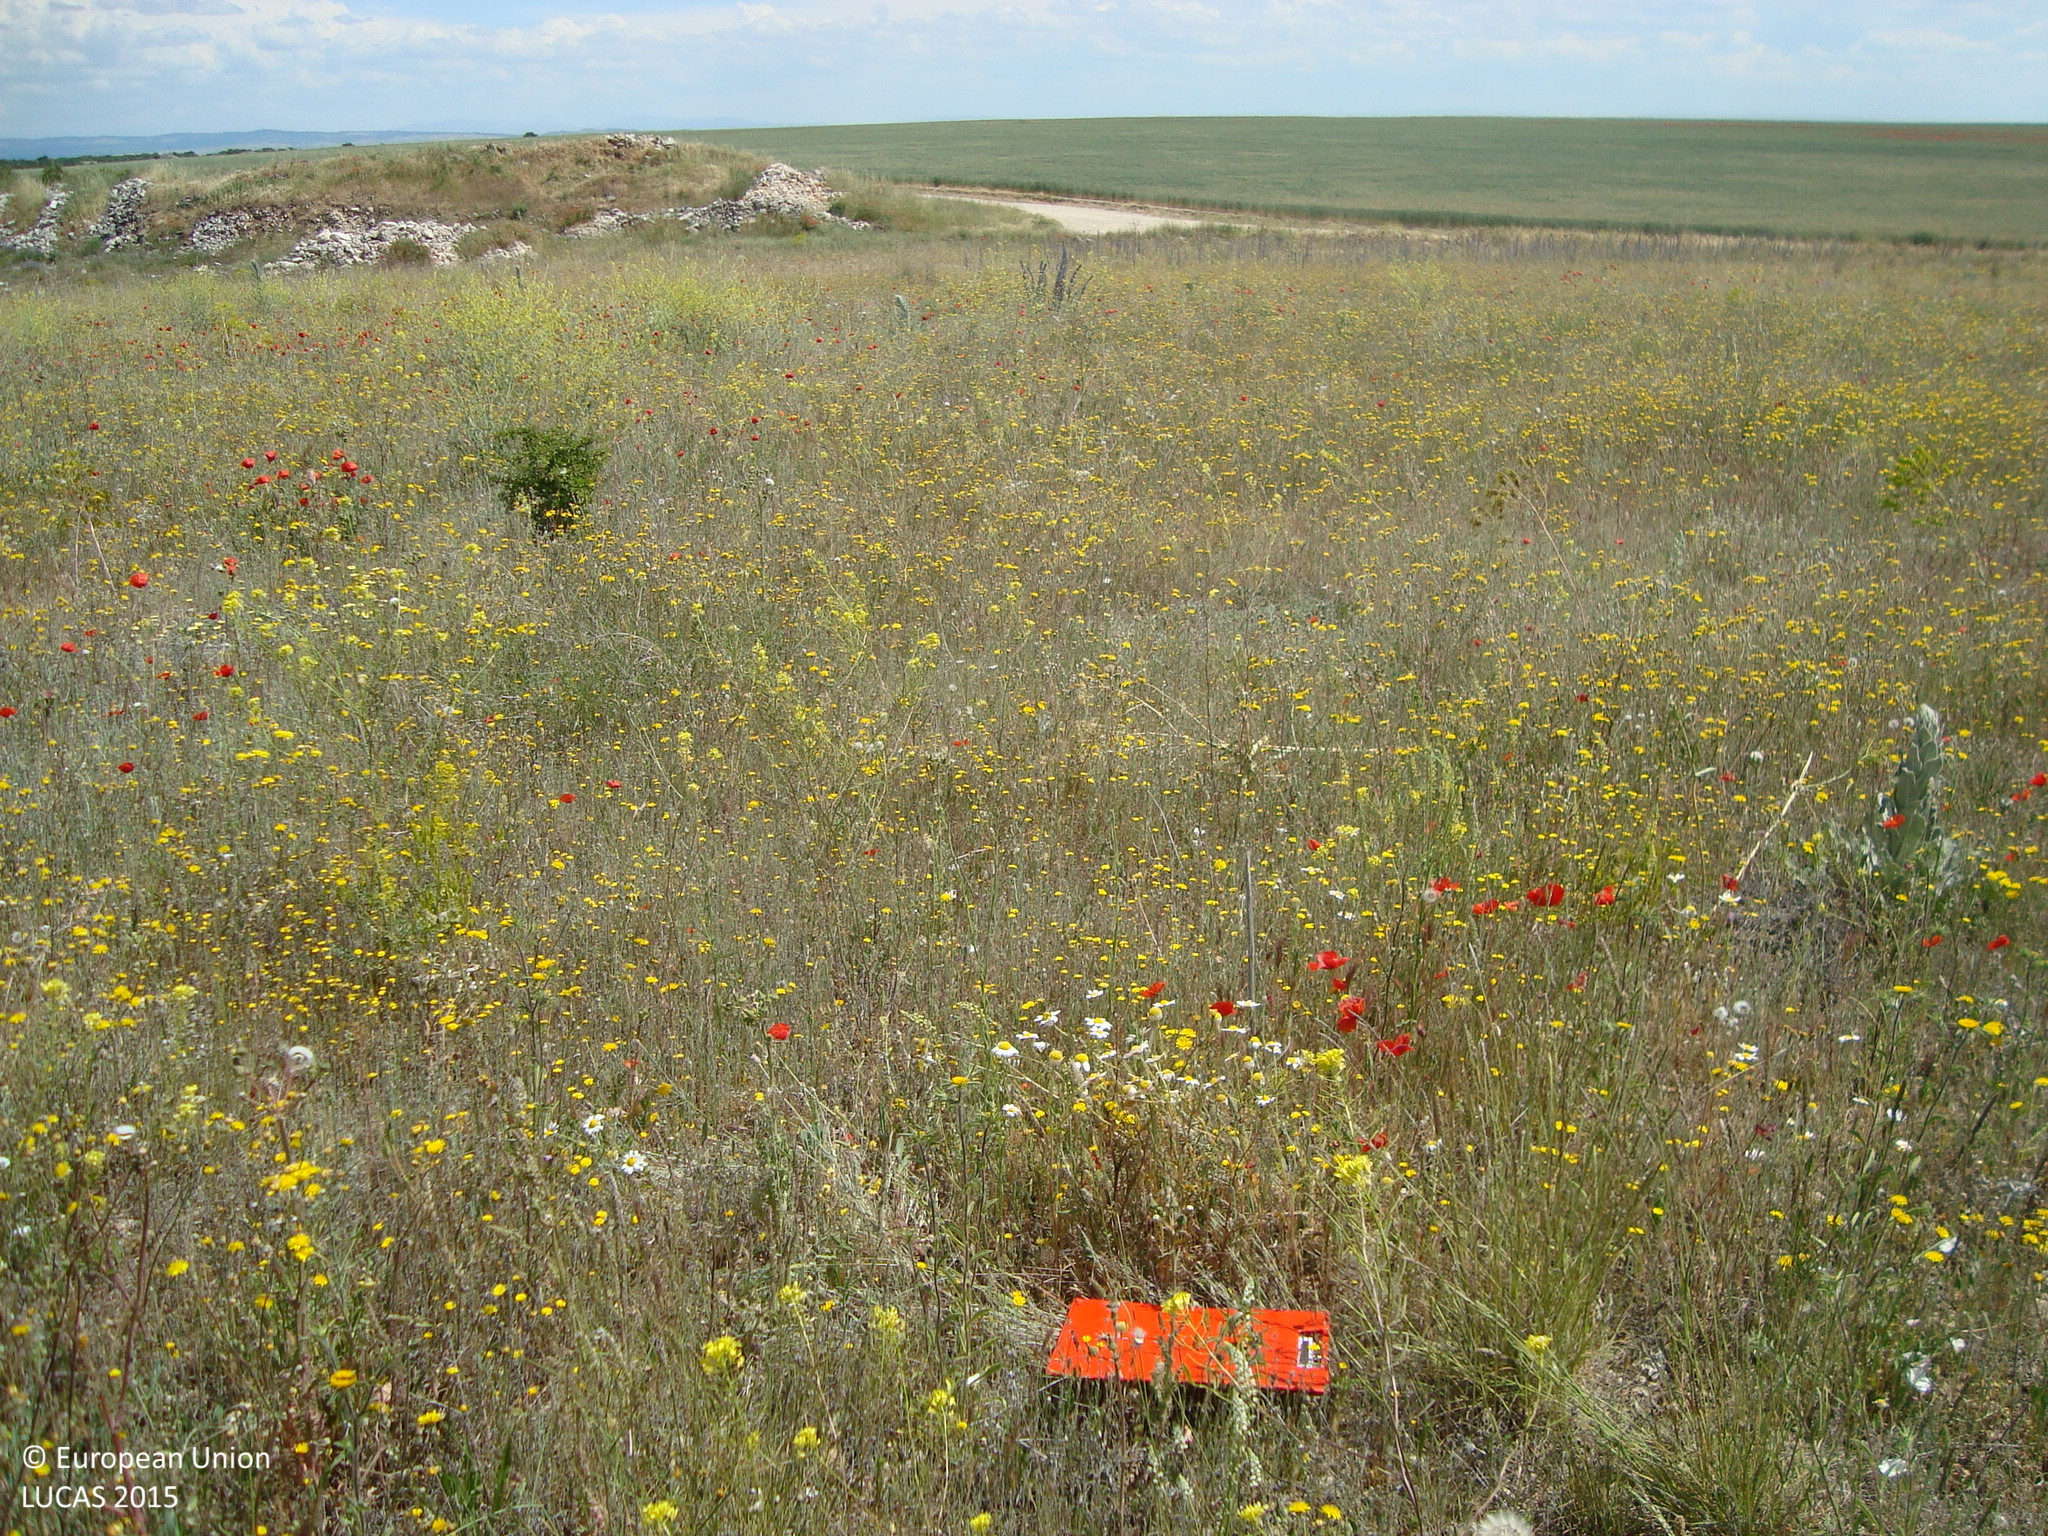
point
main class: Grassland
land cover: Grassland without tree/shrub cover
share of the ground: > 75 %
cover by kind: herbaceous plants 95 %, unconsolidated bare surface 5 %
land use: Abandoned areas
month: May
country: ES
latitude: 41.5594
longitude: -4.0497
